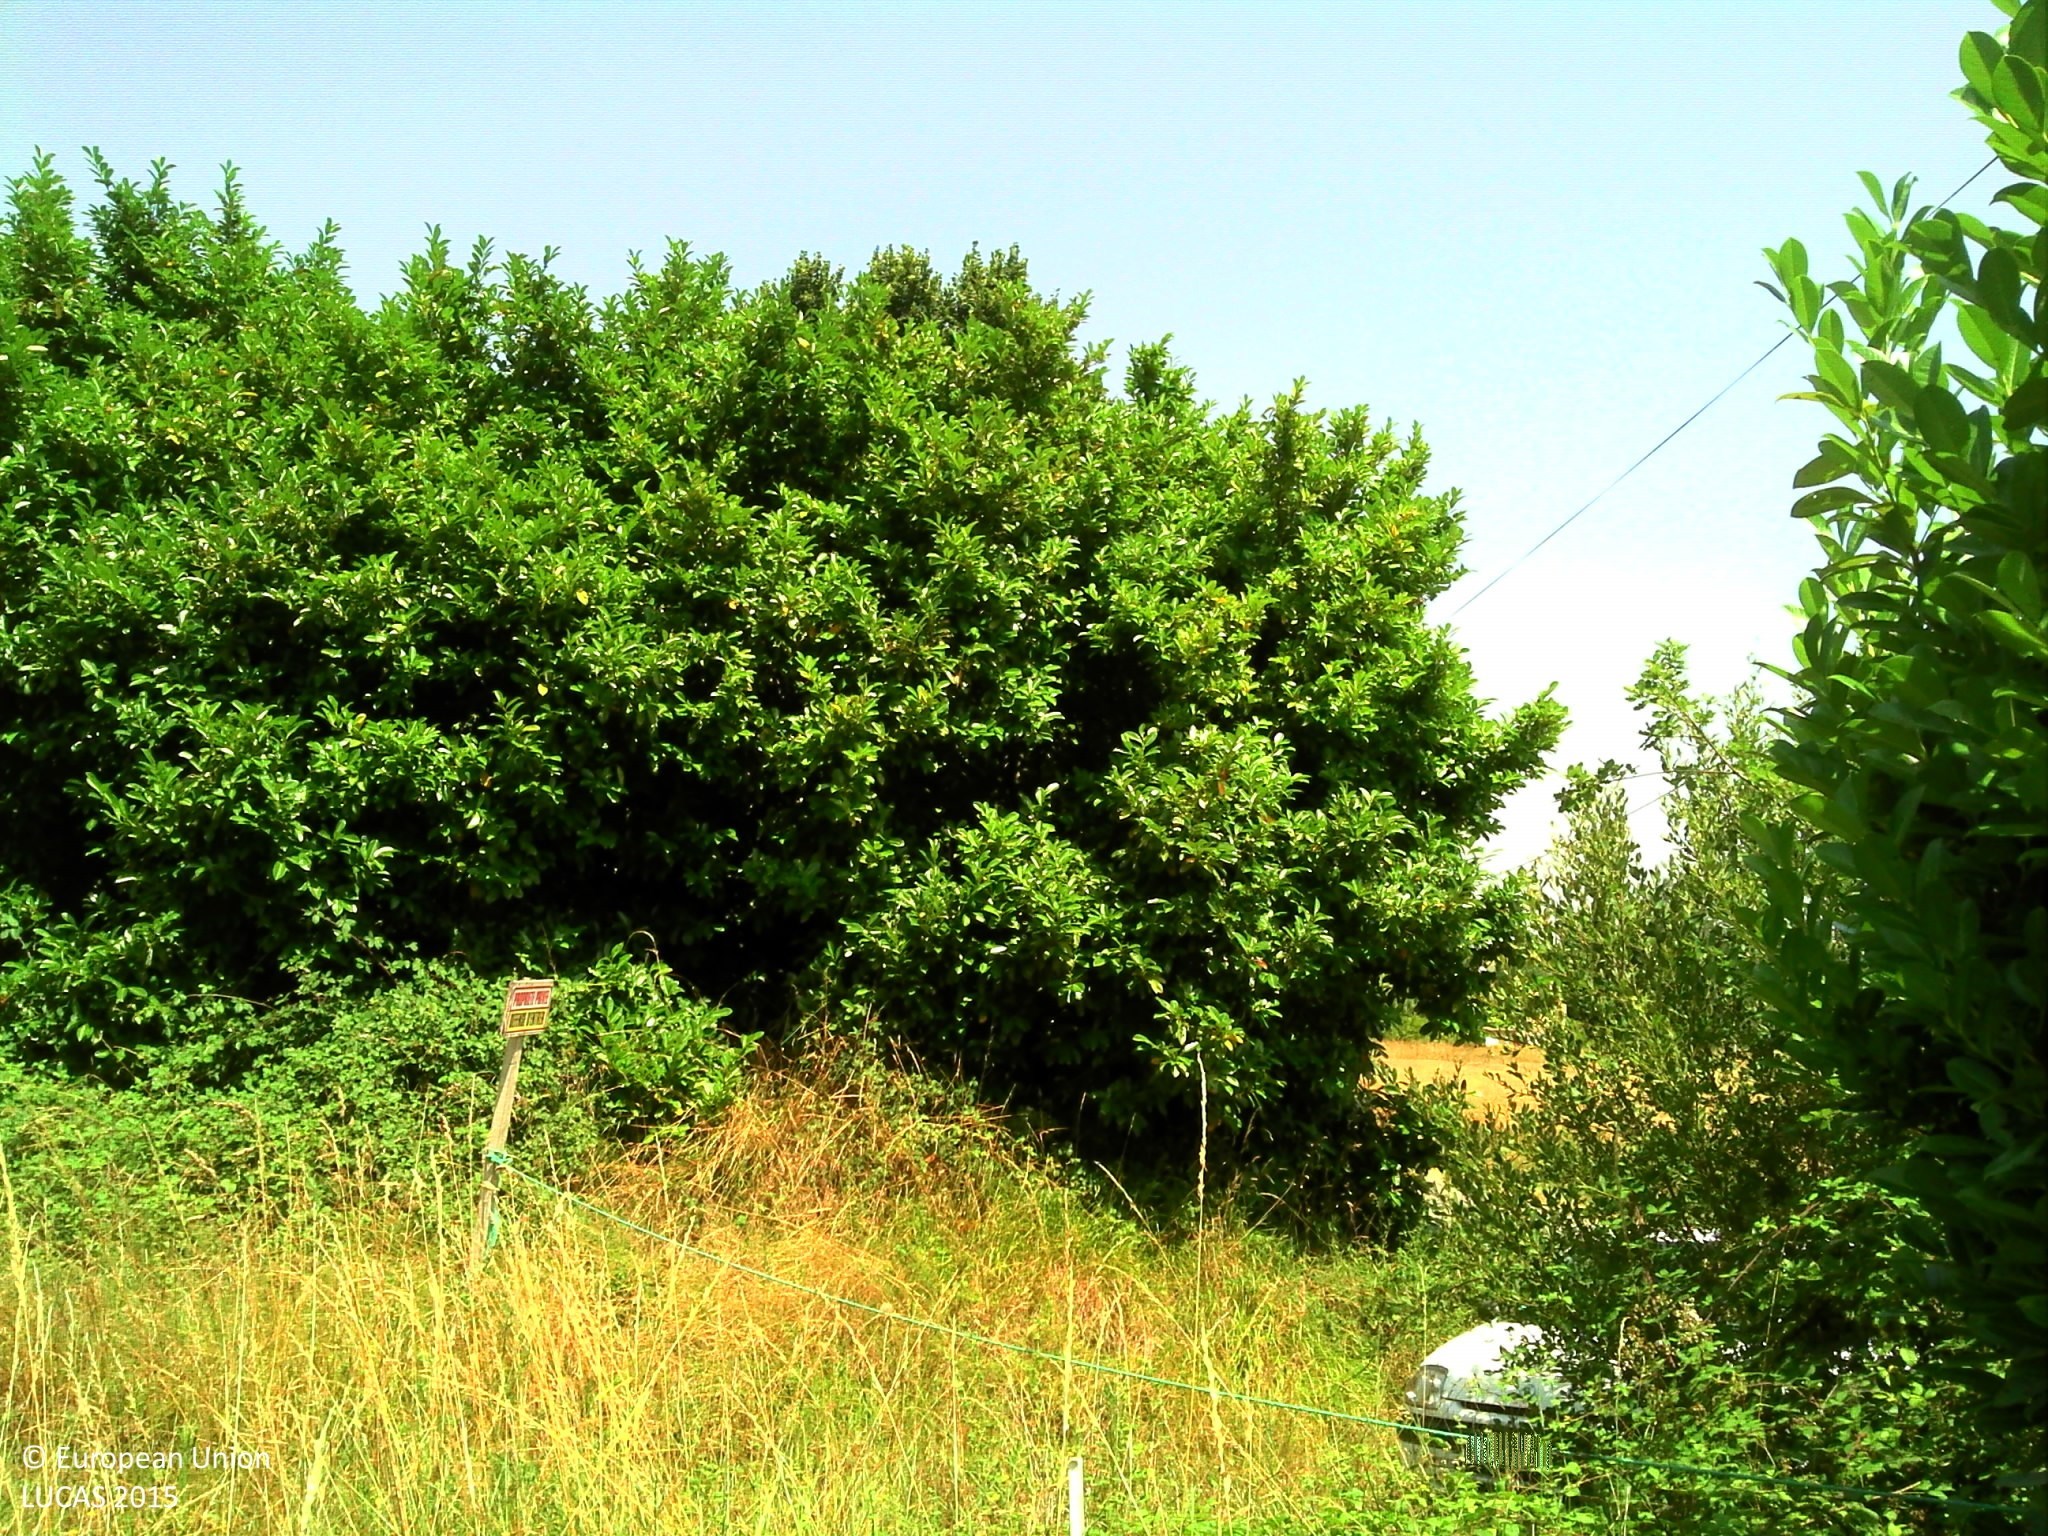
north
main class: Grassland
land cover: Spontaneously vegetated surfaces
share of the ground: > 75 %
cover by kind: herbaceous plants 95 %, shrubs 5 %
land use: Semi-natural and natural areas not in use
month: July
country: FR
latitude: 43.1436
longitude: 1.4353
